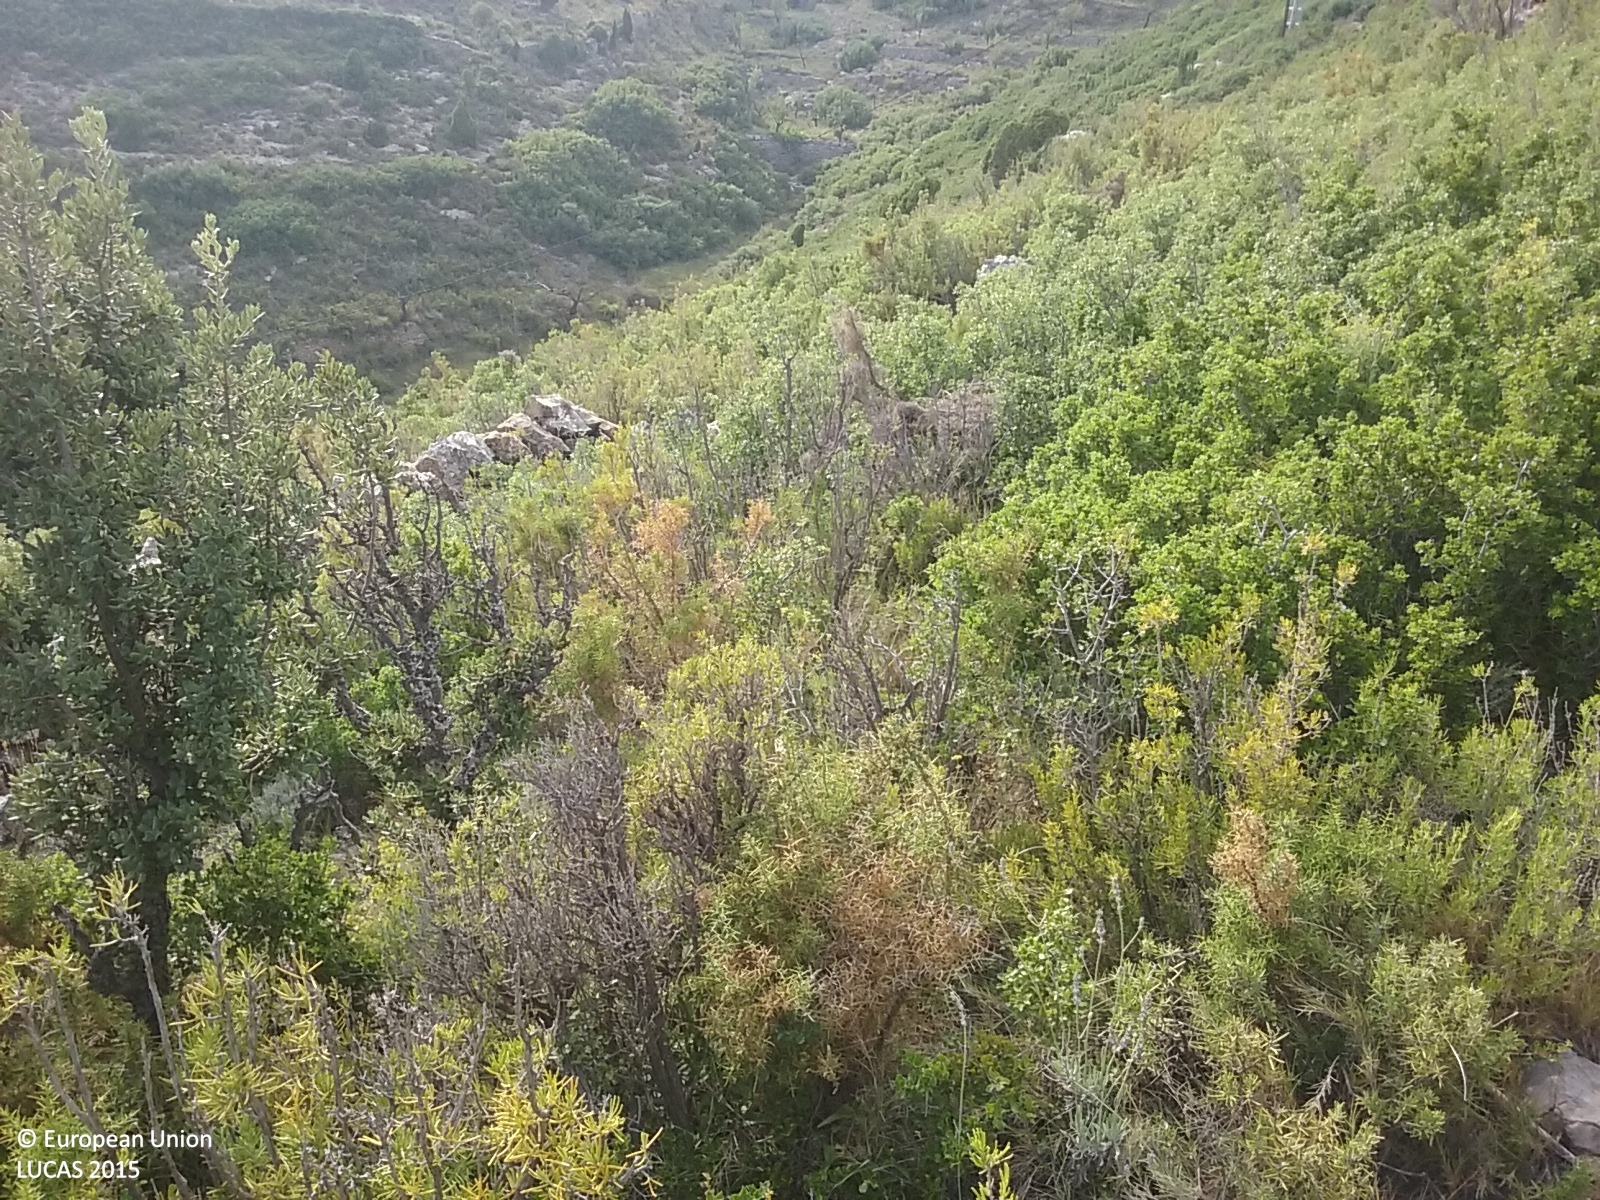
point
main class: Shrubland
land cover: Shrubland with sparse tree cover
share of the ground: > 75 %
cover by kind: shrubs 95 %, coniferous forest trees 5 %
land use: Semi-natural and natural areas not in use
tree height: < 5 m
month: August
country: ES
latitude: 40.3466
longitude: -0.0942
